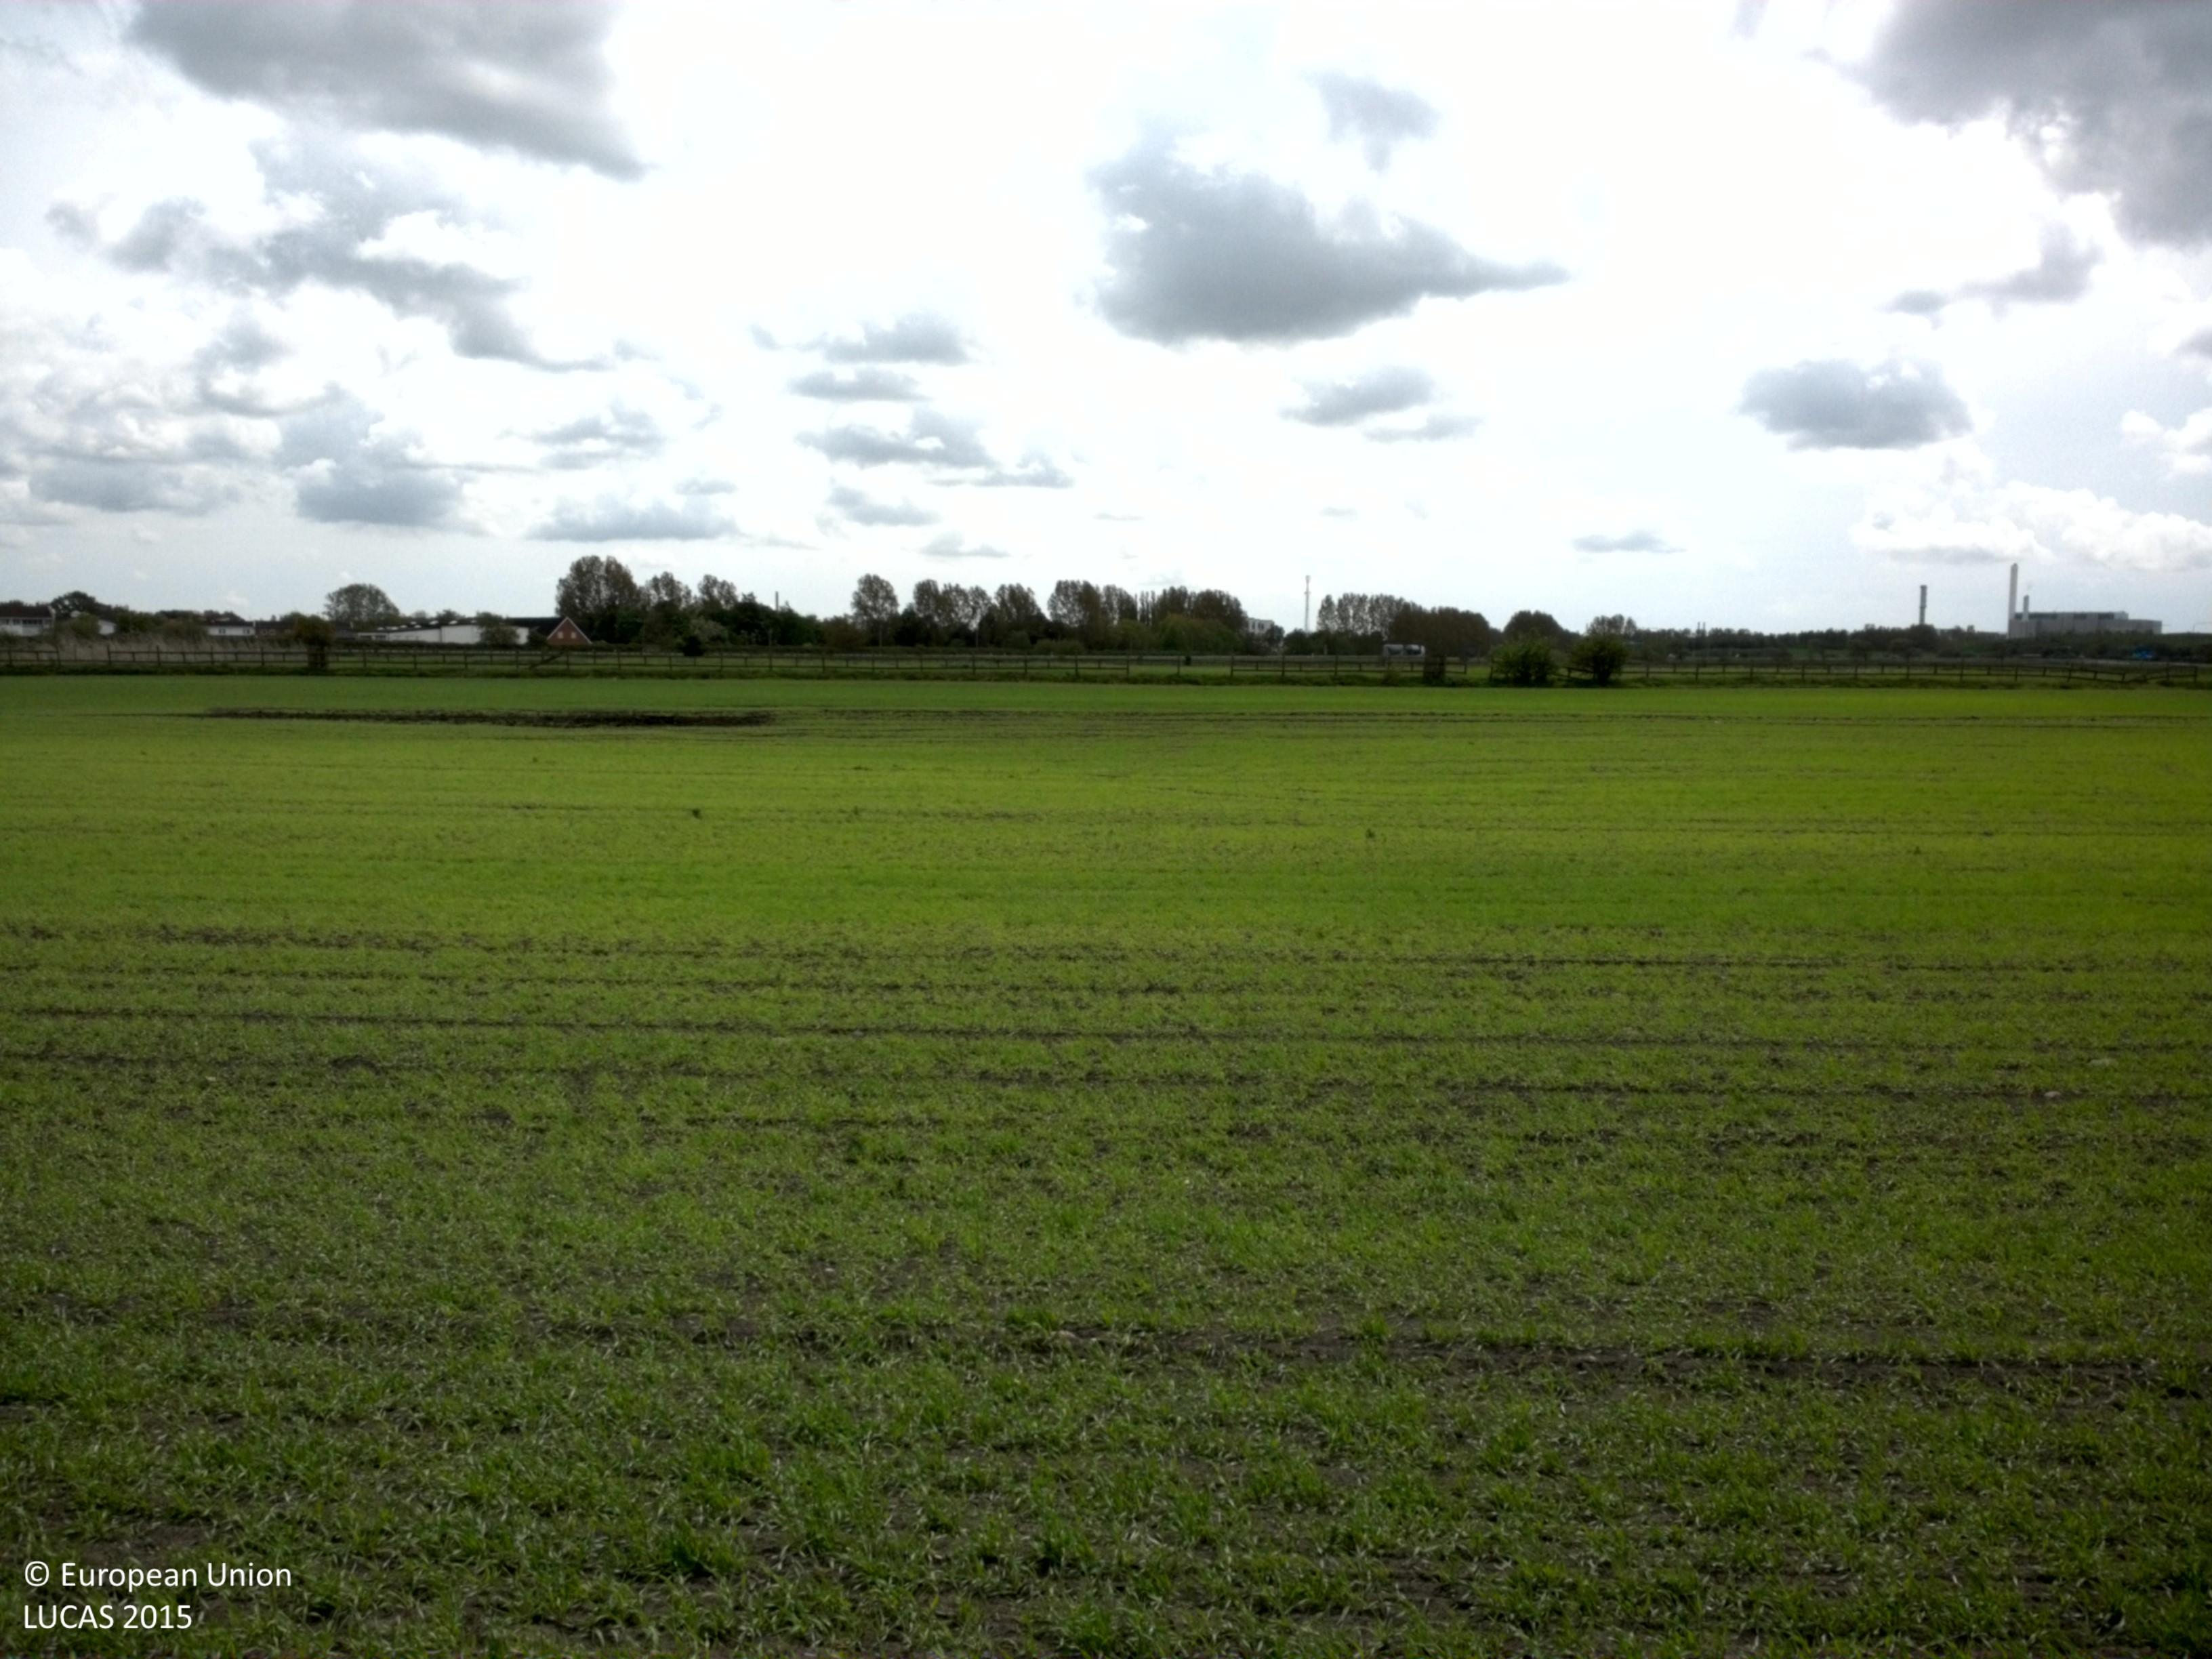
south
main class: Cropland
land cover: Barley
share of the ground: > 75 %
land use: Agriculture (excluding fallow land and kitchen gardens)
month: May
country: SE
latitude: 55.6475
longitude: 13.0648
